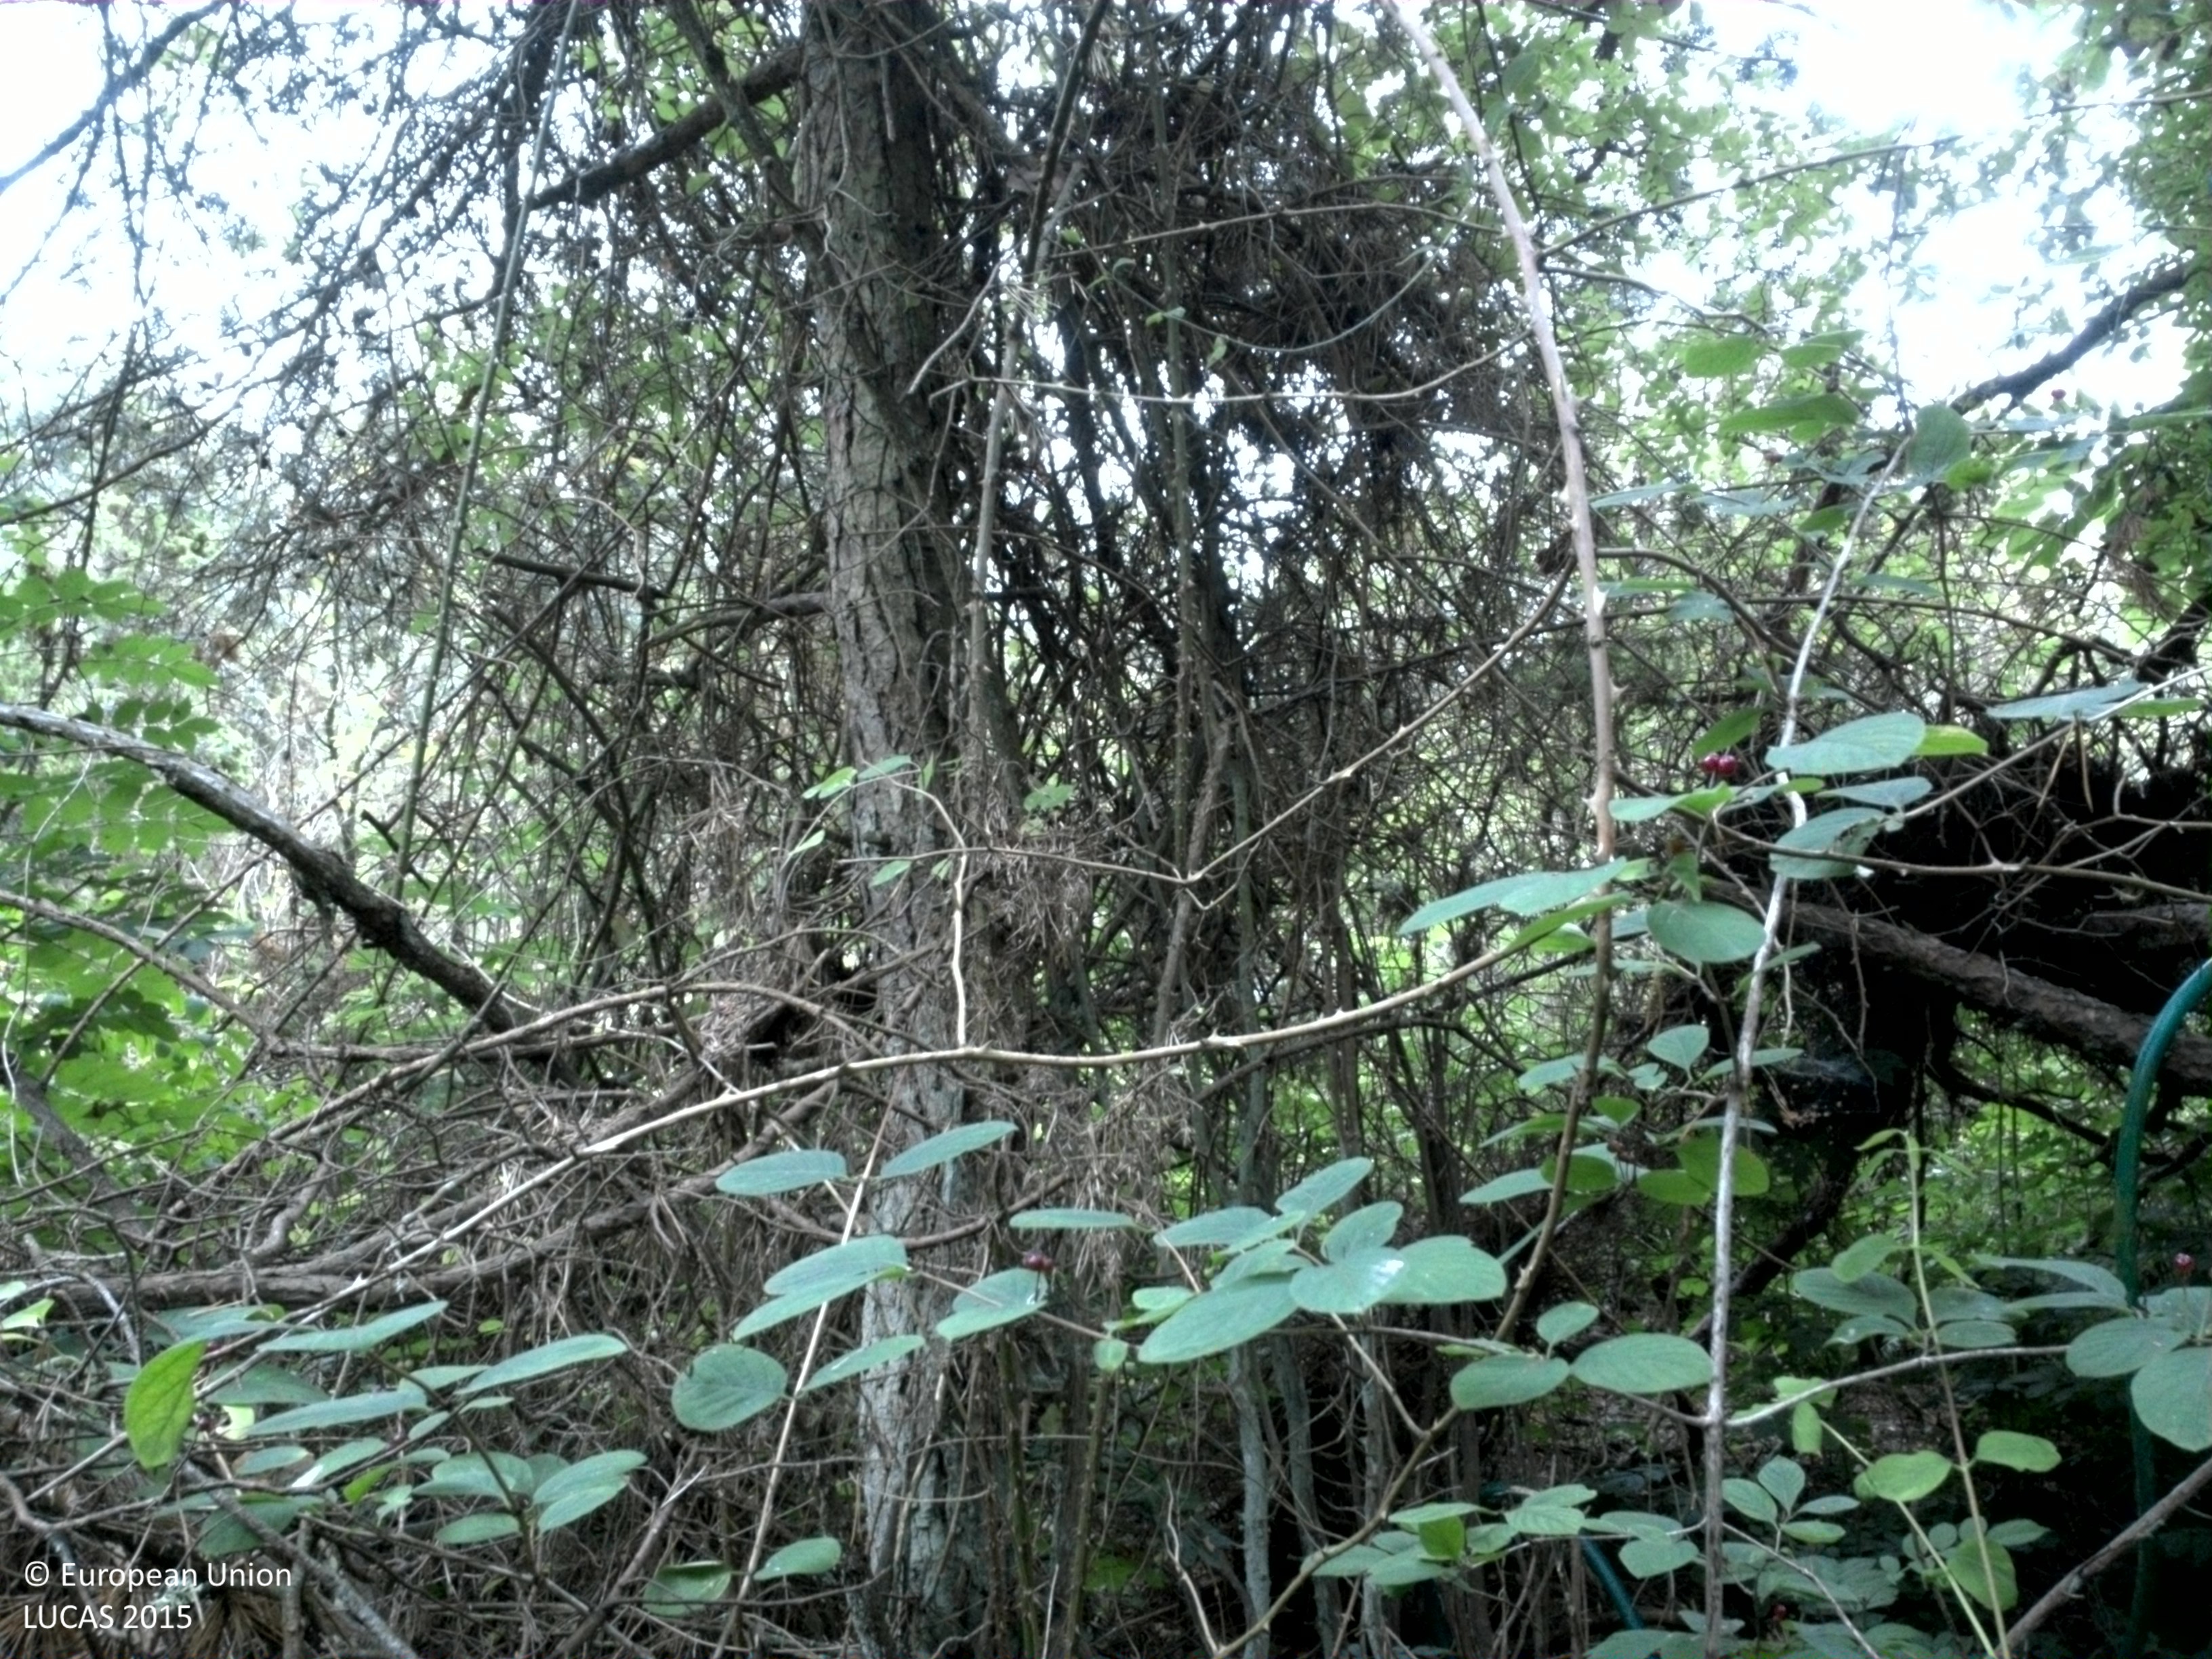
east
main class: Woodland
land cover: Pine dominated coniferous woodland
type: hemiboreal forest and nemoral coniferous forest and mixed broadleaved-coniferous forest
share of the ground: > 75 %
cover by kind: coniferous forest trees 75 %, shrubs 15 %, broadleaved forest trees 5 %, herbaceous plants 5 %
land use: Forestry
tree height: > 5 m
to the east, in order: Pine dominated coniferous woodland; Tracks; Pine dominated coniferous woodland; Dry stone walls; Permanent industrial crops
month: July
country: SE
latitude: 57.2214
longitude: 18.5723
